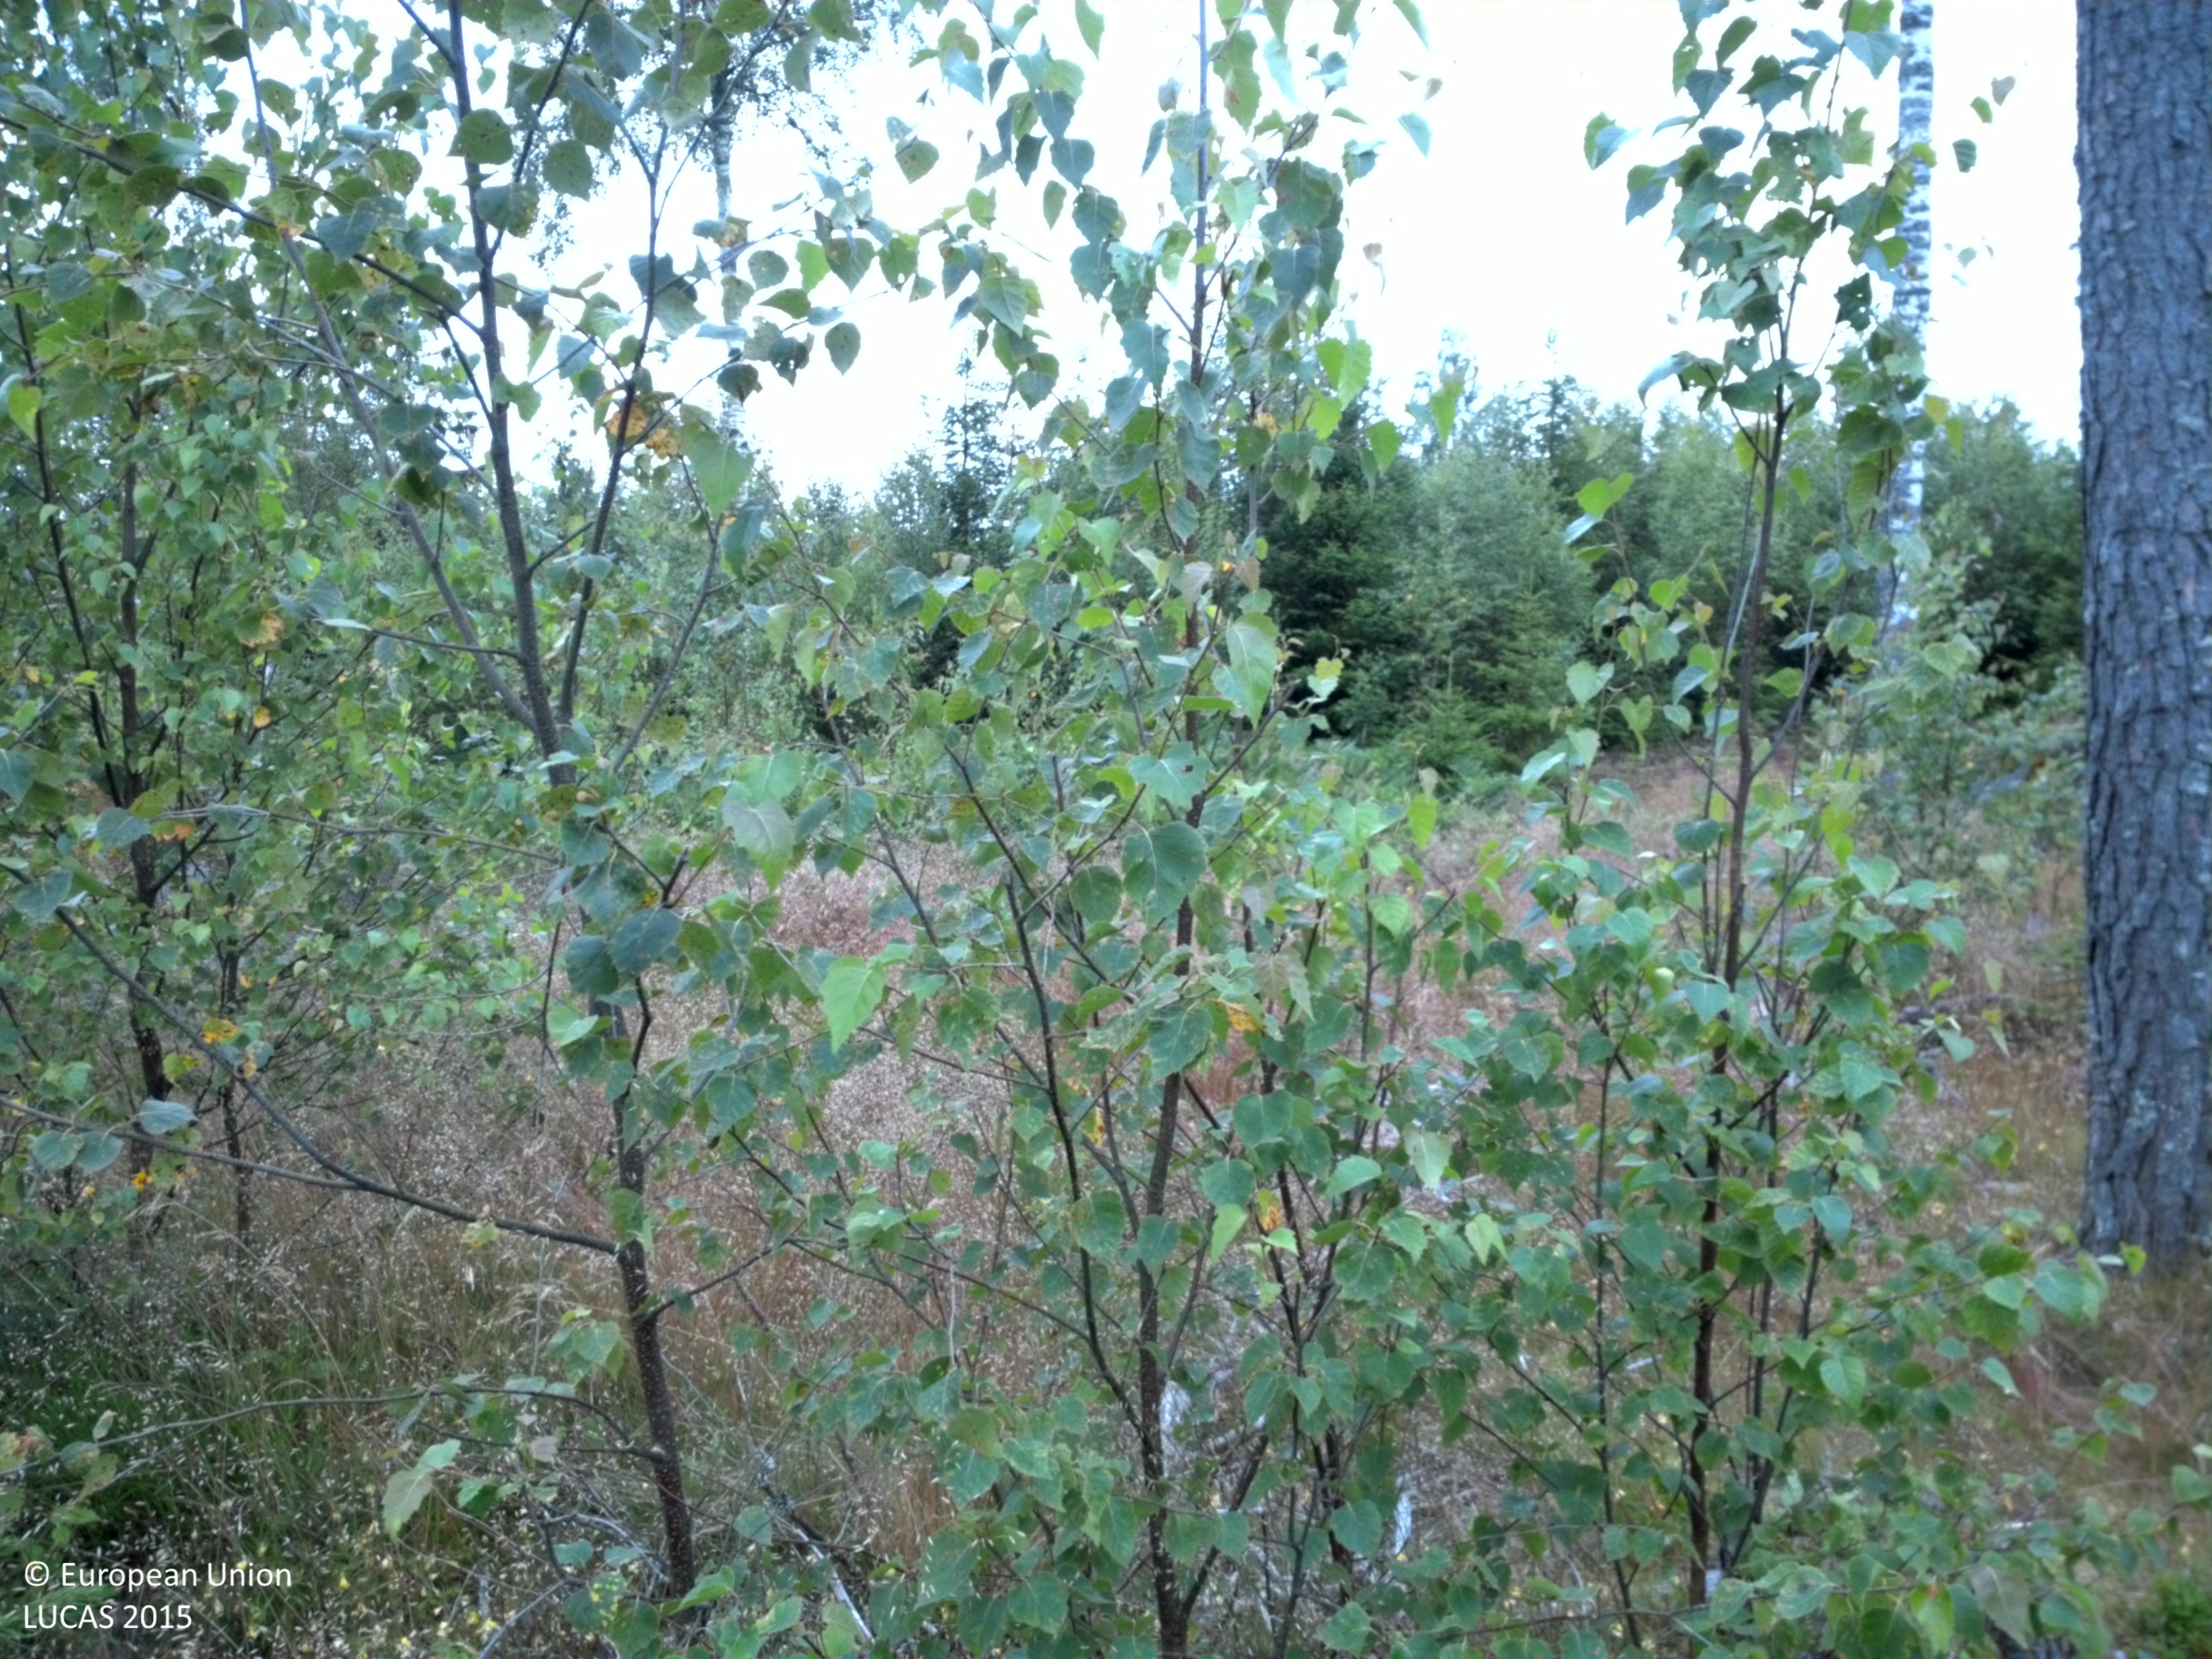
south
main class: Woodland
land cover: Spruce dominated mixed woodland
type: boreal forest
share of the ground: 50 - 75 %
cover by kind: coniferous forest trees 35 %, herbaceous plants 35 %, broadleaved forest trees 25 %, shrubs 5 %
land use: Forestry
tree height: < 5 m
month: July
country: SE
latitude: 58.8969
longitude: 14.6265
